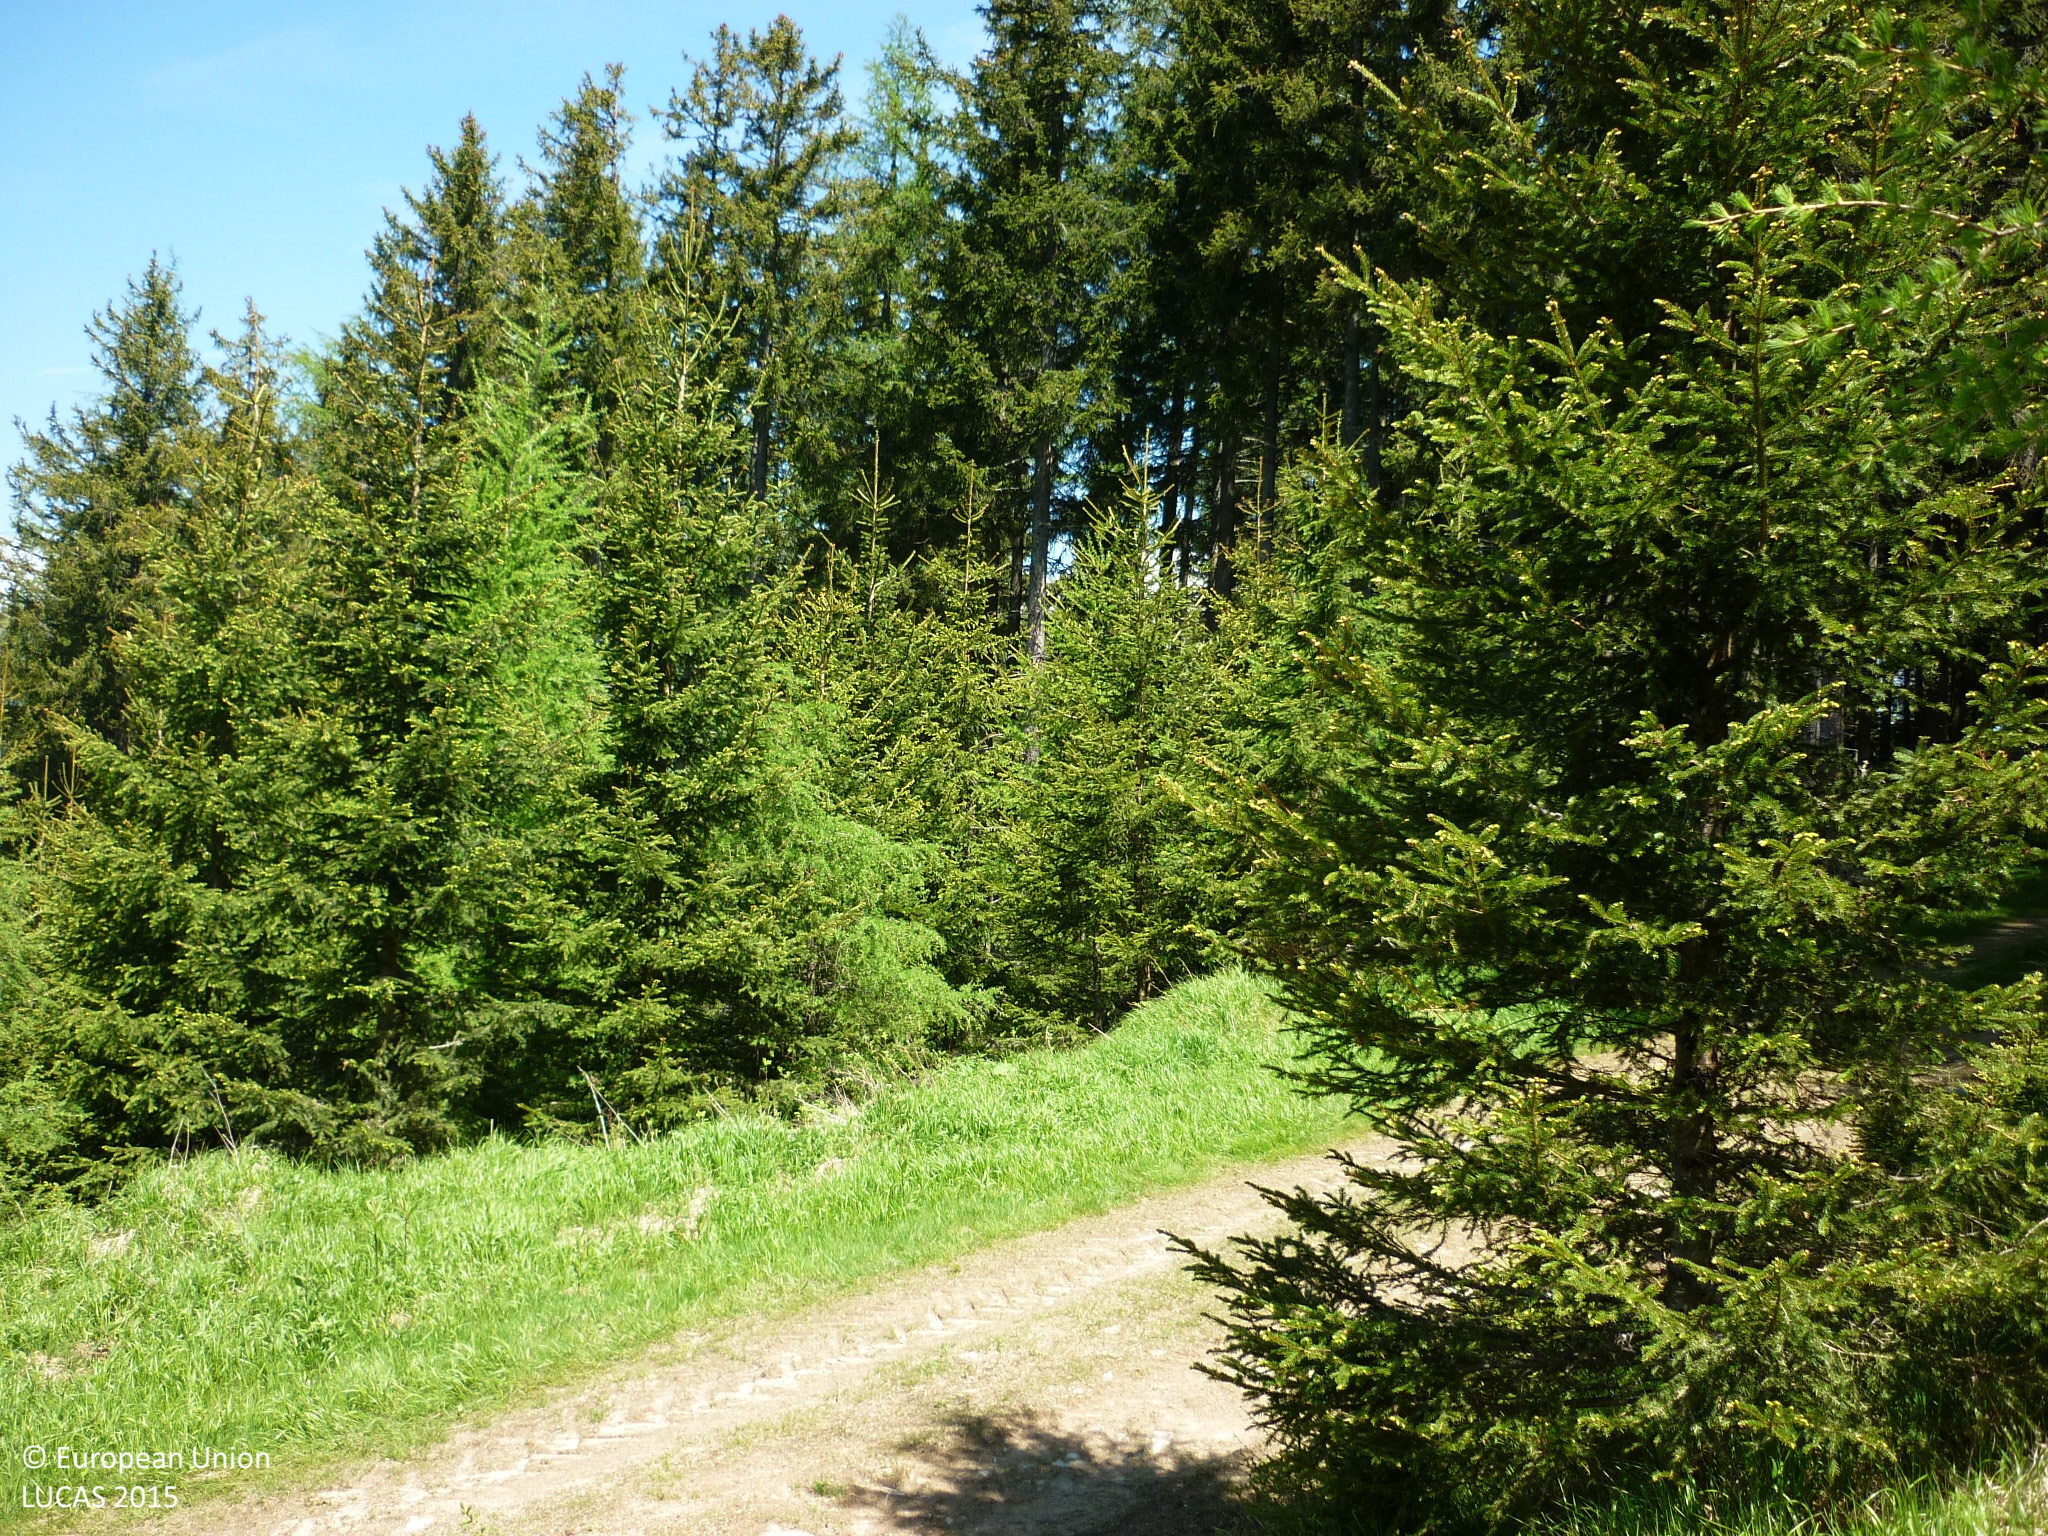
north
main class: Woodland
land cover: Other coniferous woodland
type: alpine coniferous forest
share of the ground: 50 - 75 %
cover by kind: coniferous forest trees 65 %, herbaceous plants 35 %
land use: Forestry
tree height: > 5 m
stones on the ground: < 10 %
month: May
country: AT
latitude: 47.3221
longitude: 14.8815
